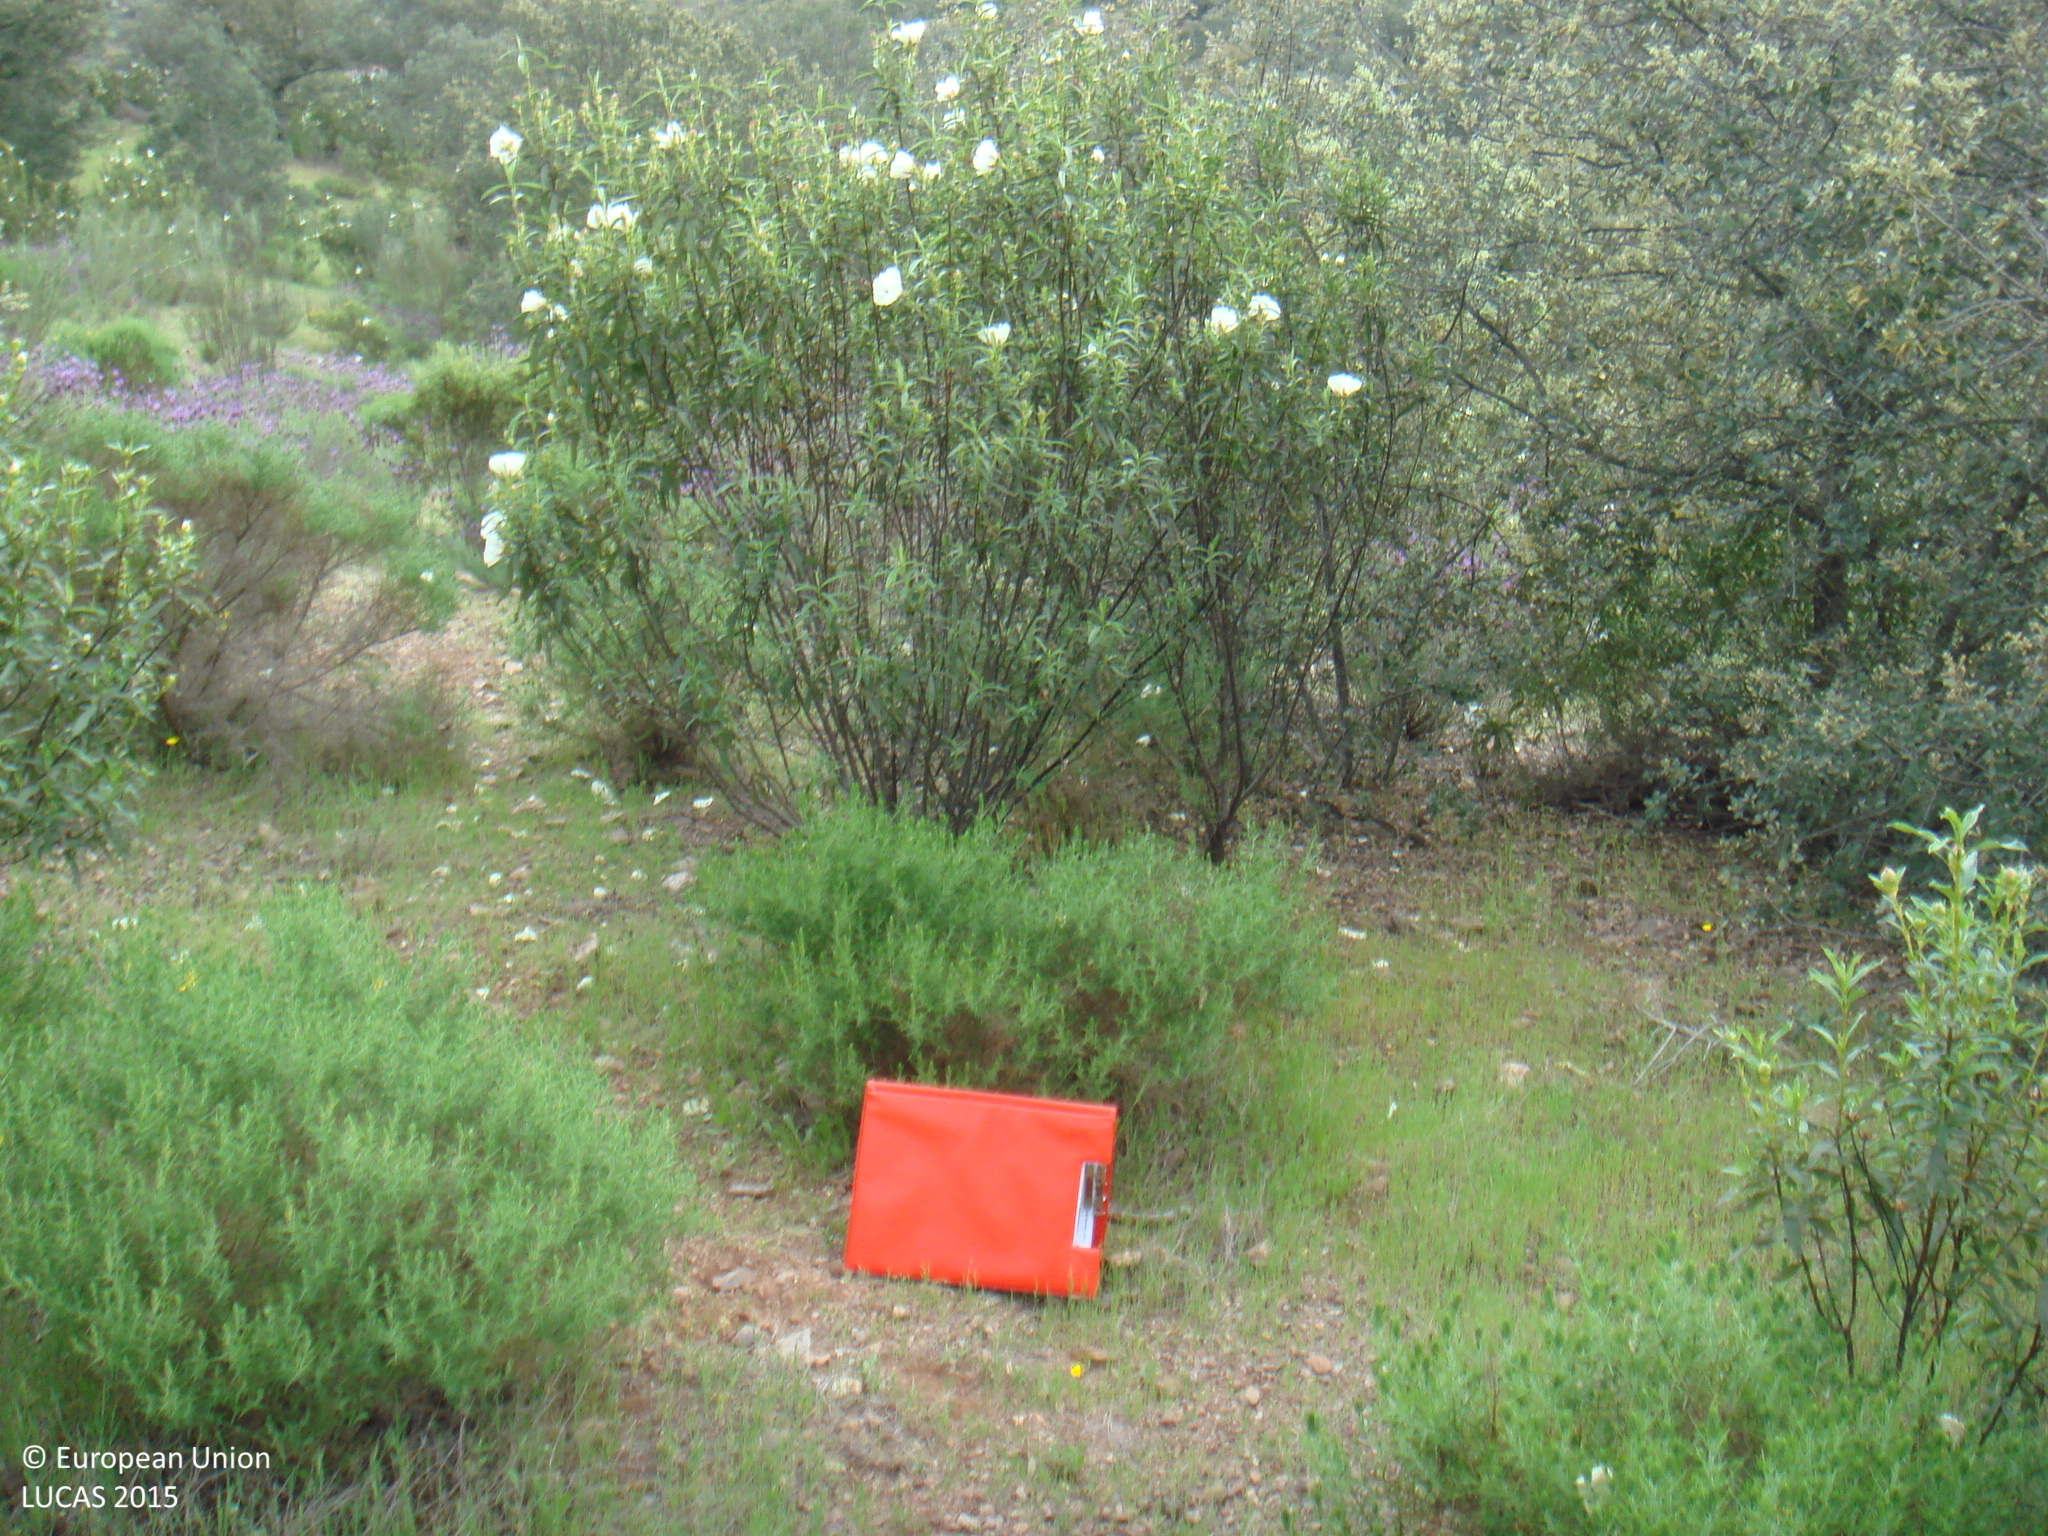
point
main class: Woodland
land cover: Broadleaved woodland
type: broadleaved evergreen forest
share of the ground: 10 - 25 %
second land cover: Shrubland without tree cover
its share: 50 - 75 %
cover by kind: shrubs 65 %, broadleaved forest trees 20 %, unconsolidated bare surface 10 %, herbaceous plants 5 %
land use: Forestry
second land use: Agriculture (excluding fallow land and kitchen gardens)
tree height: < 5 m
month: April
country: ES
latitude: 38.1610
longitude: -5.0538
